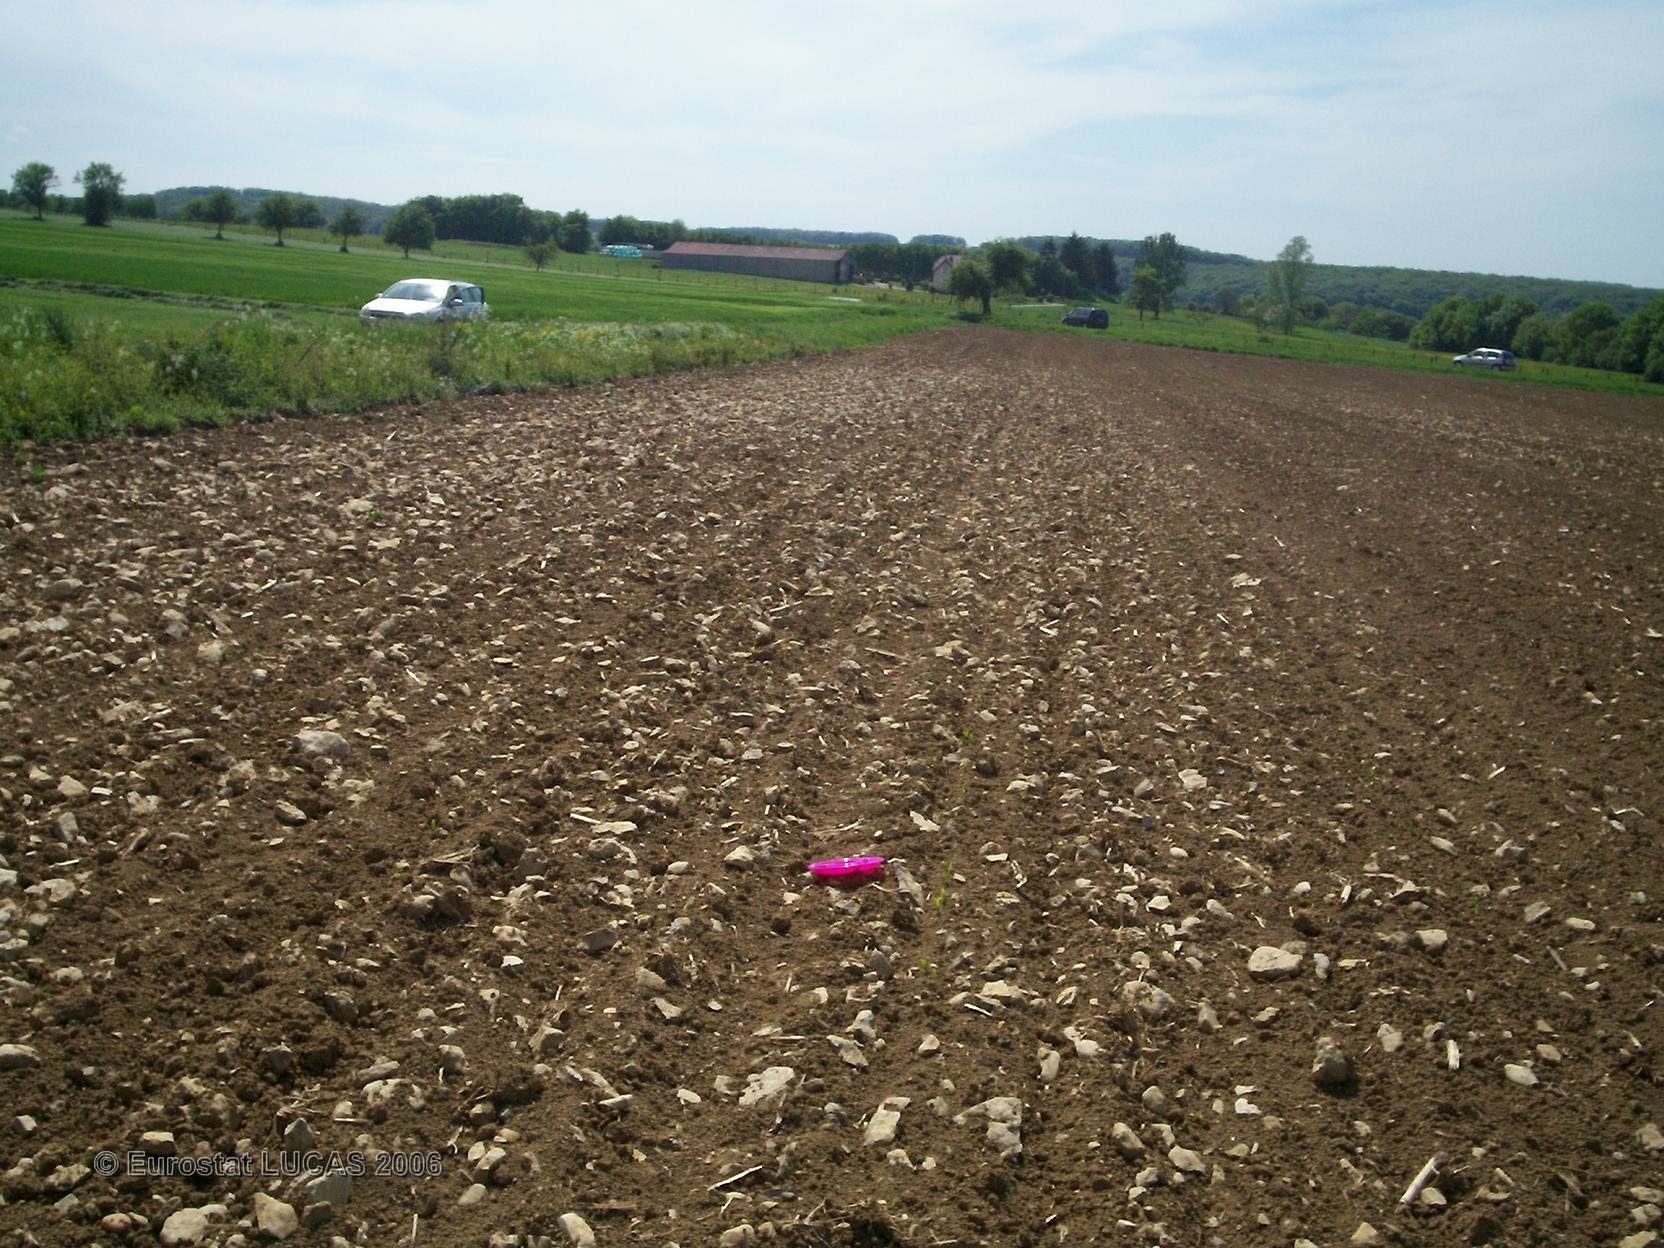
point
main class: Cropland
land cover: Maize
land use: Agriculture (excluding fallow land and kitchen gardens)
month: May
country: FR
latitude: 48.7789
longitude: 7.0747
